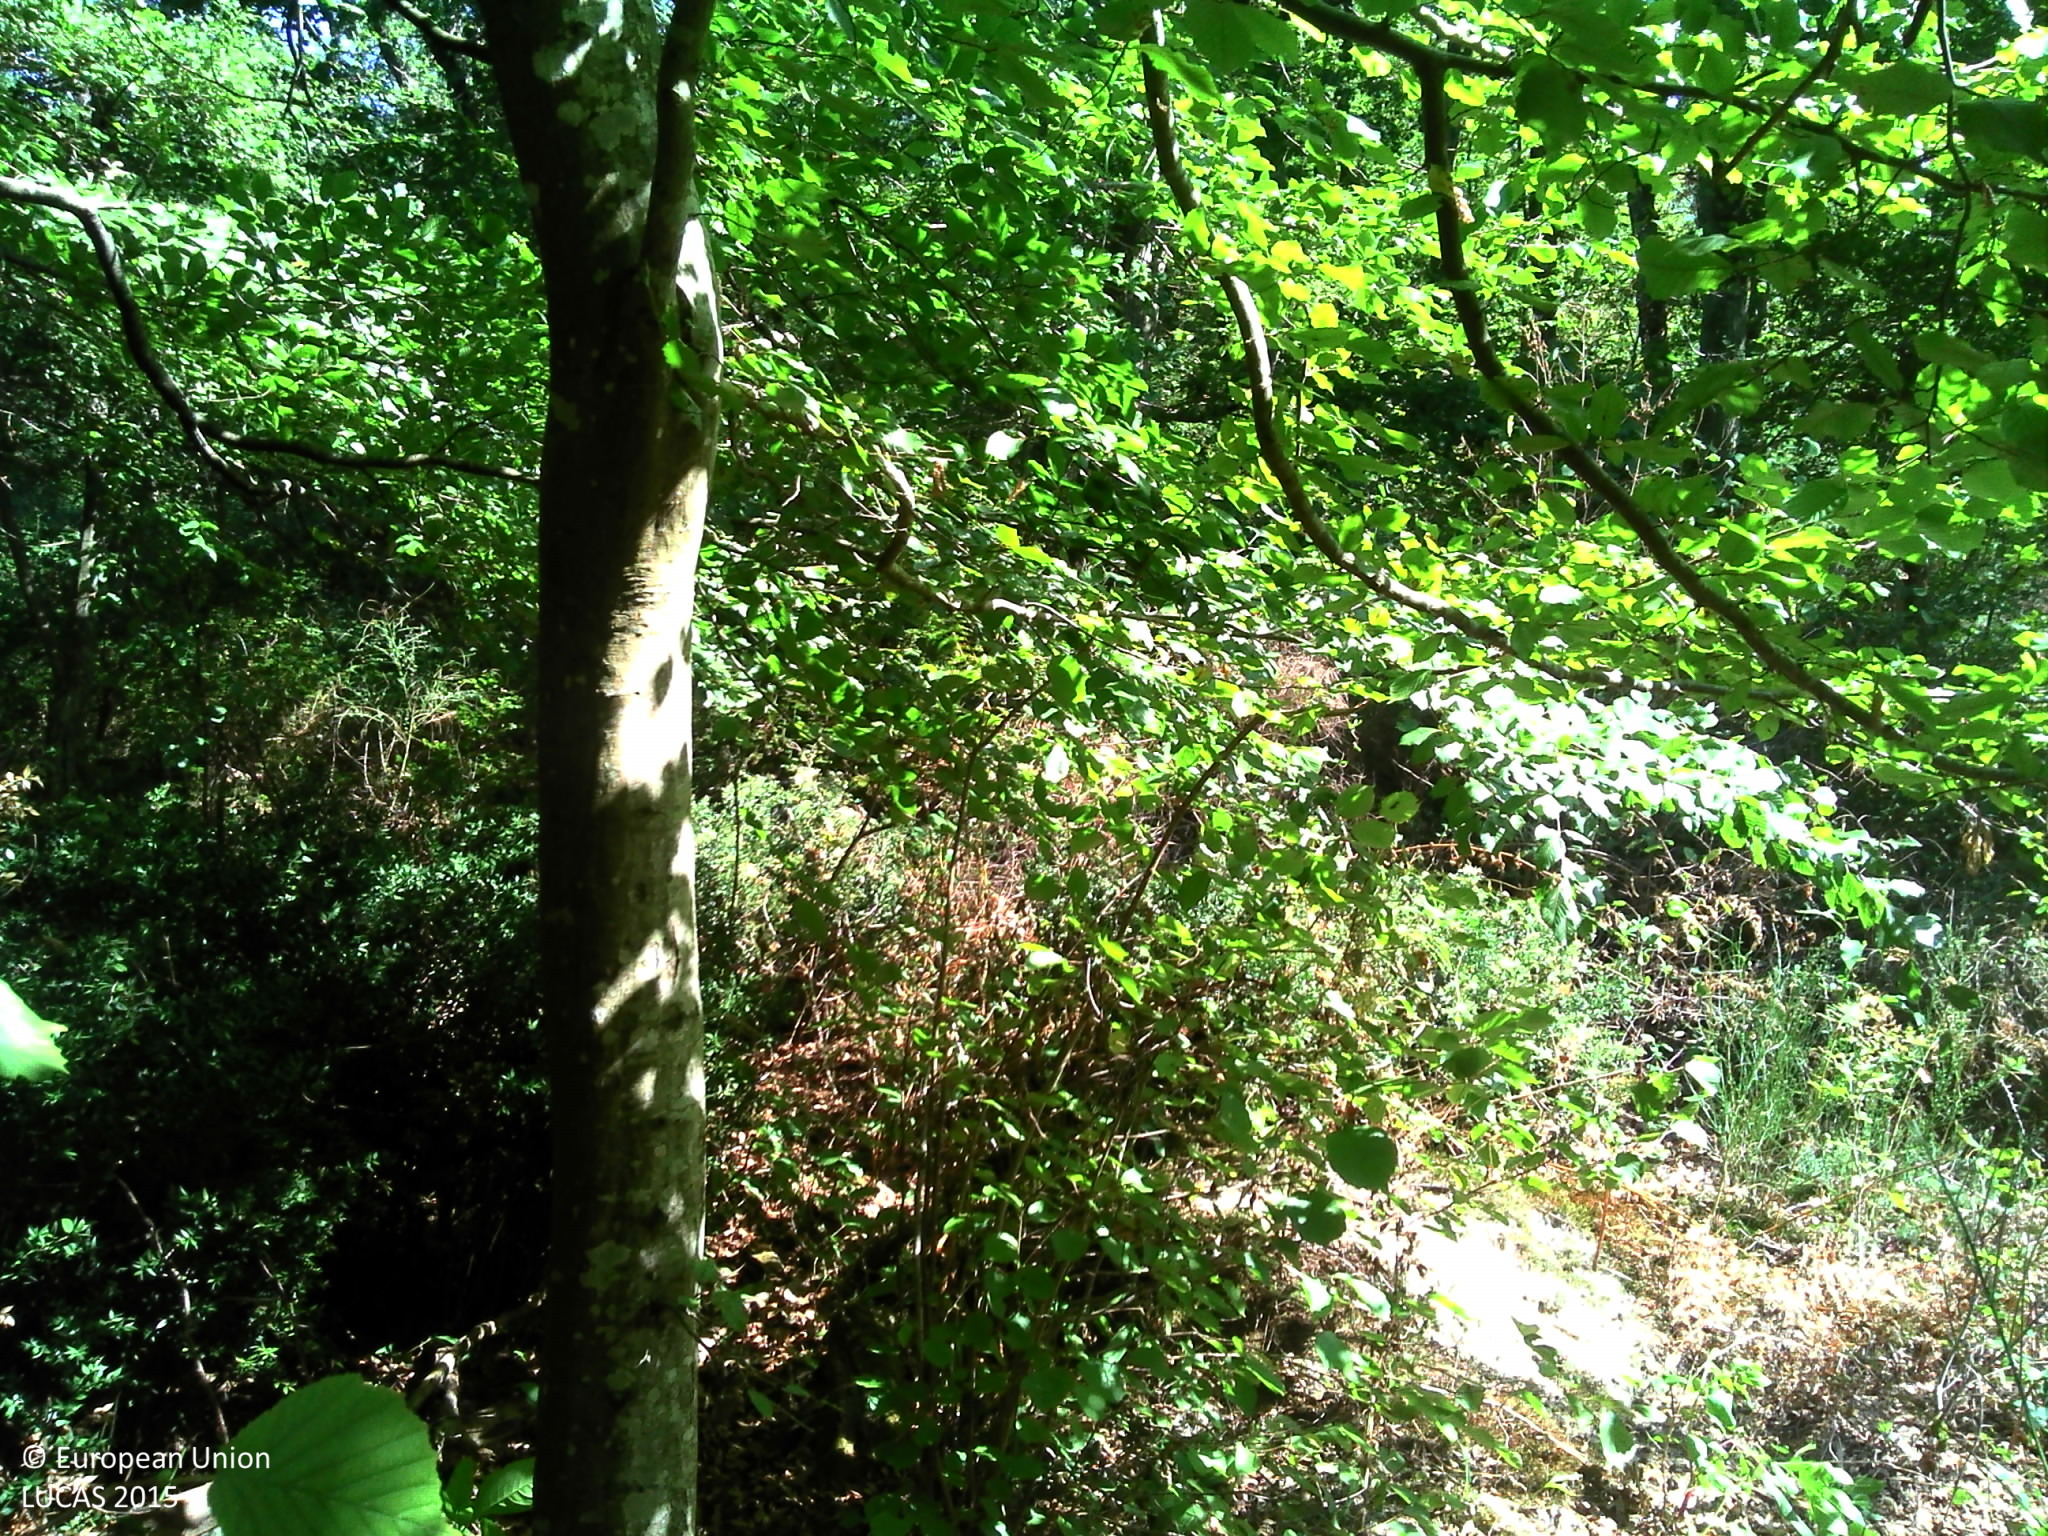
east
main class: Woodland
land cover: Broadleaved woodland
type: mesophytic deciduous forest
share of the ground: > 75 %
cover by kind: broadleaved forest trees 80 %, shrubs 10 %, herbaceous plants 5 %, lichens and mosses 5 %
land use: Forestry
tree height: > 5 m
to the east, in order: Broadleaved woodland; Grass margins; Artificial constructions in urban areas; Broadleaved woodland; Tracks; Broadleaved woodland
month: September
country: FR
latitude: 48.3457
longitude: 2.7453
